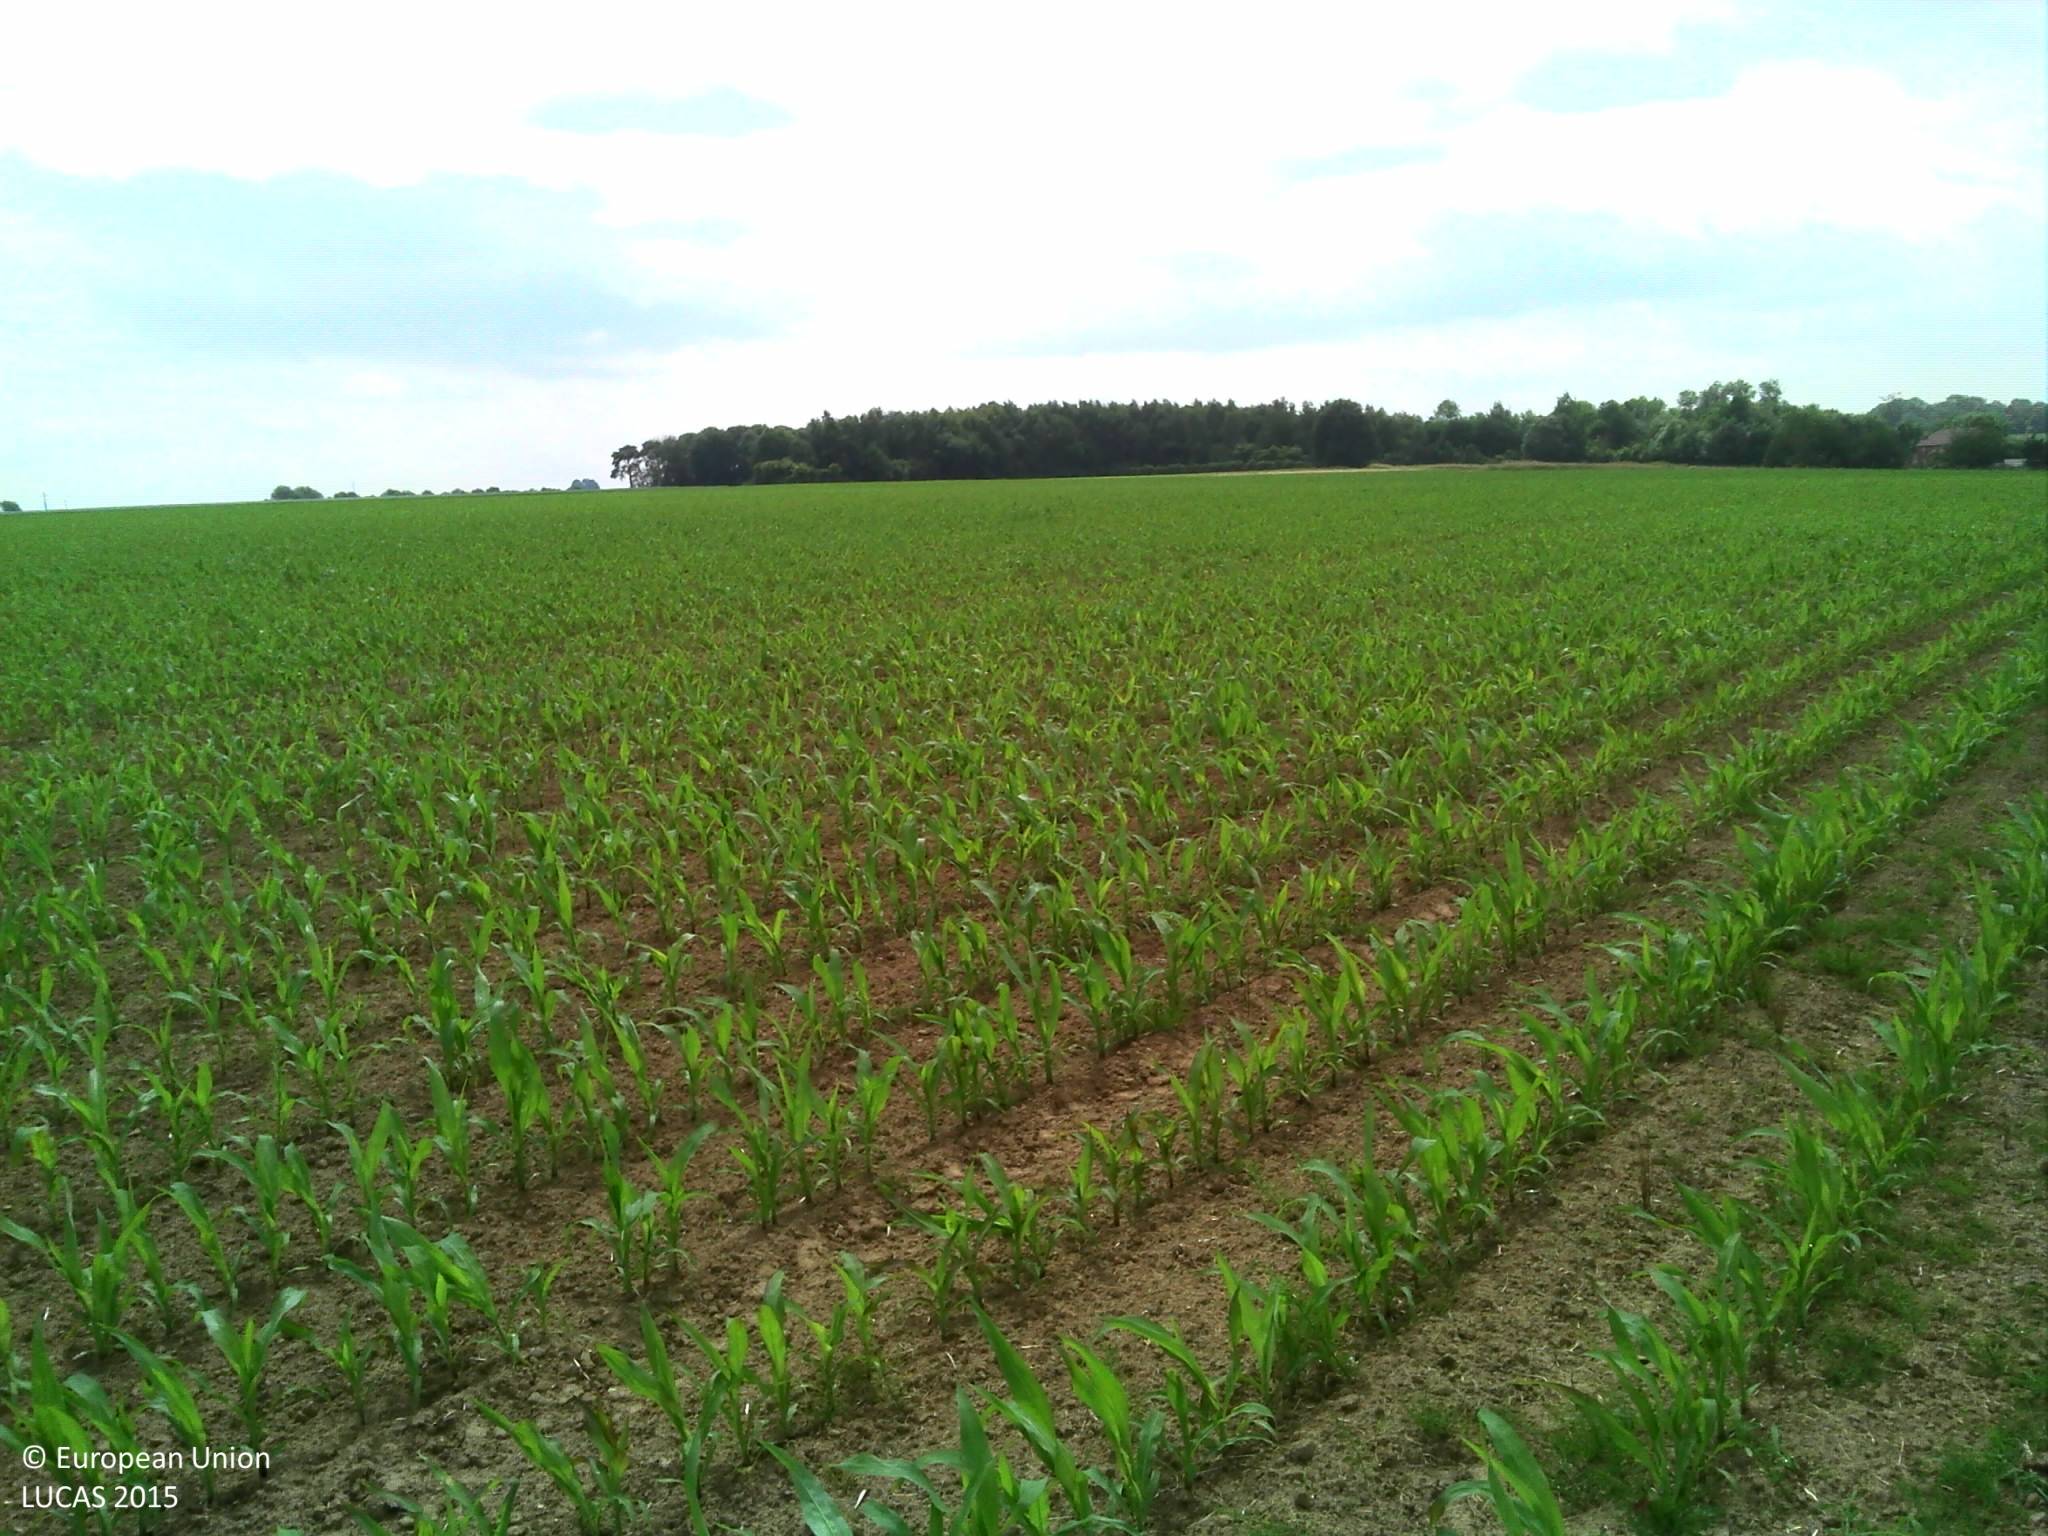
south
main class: Grassland
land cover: Grassland with sparse tree/shrub cover
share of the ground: > 75 %
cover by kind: herbaceous plants 95 %, broadleaved forest trees 5 %
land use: Residential
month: June
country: BE
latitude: 50.3876
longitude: 3.6779
